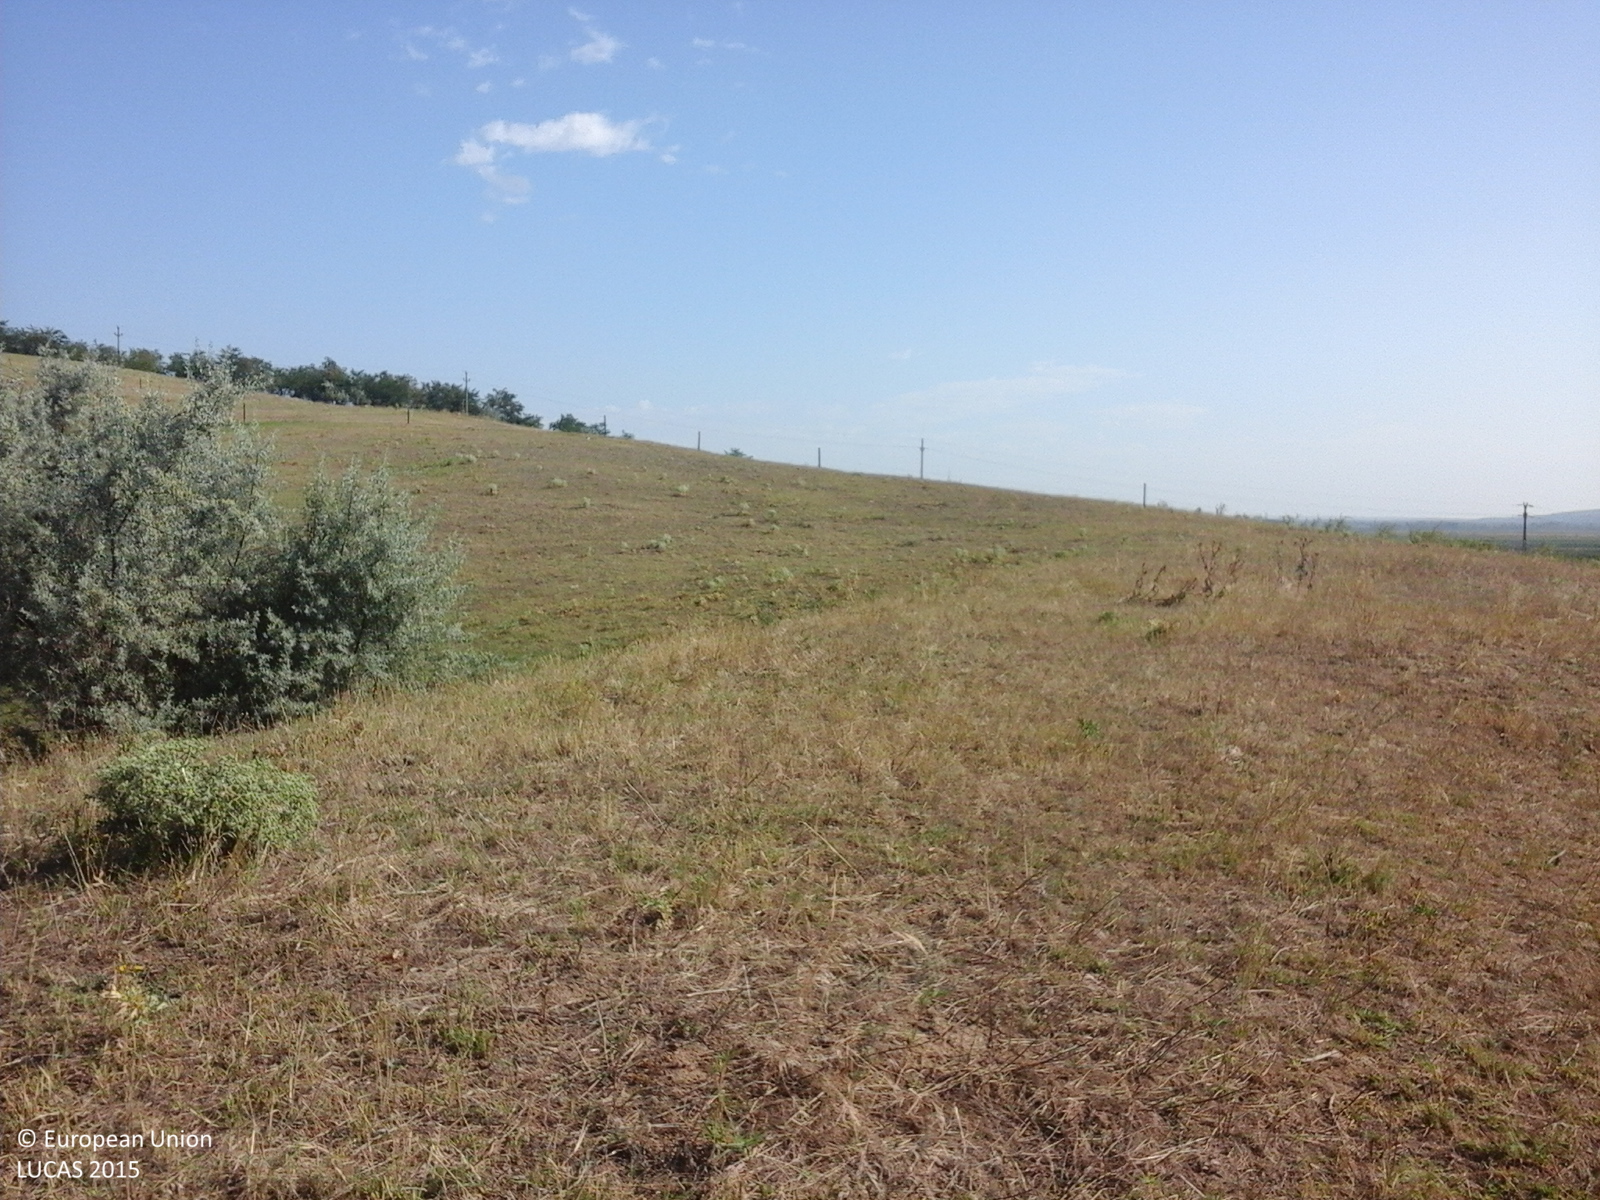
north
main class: Grassland
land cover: Grassland with sparse tree/shrub cover
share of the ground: > 75 %
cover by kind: herbaceous plants 85 %, shrubs 10 %, broadleaved forest trees 5 %
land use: Agriculture (excluding fallow land and kitchen gardens)
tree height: < 5 m
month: July
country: RO
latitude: 46.3138
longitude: 28.1411
